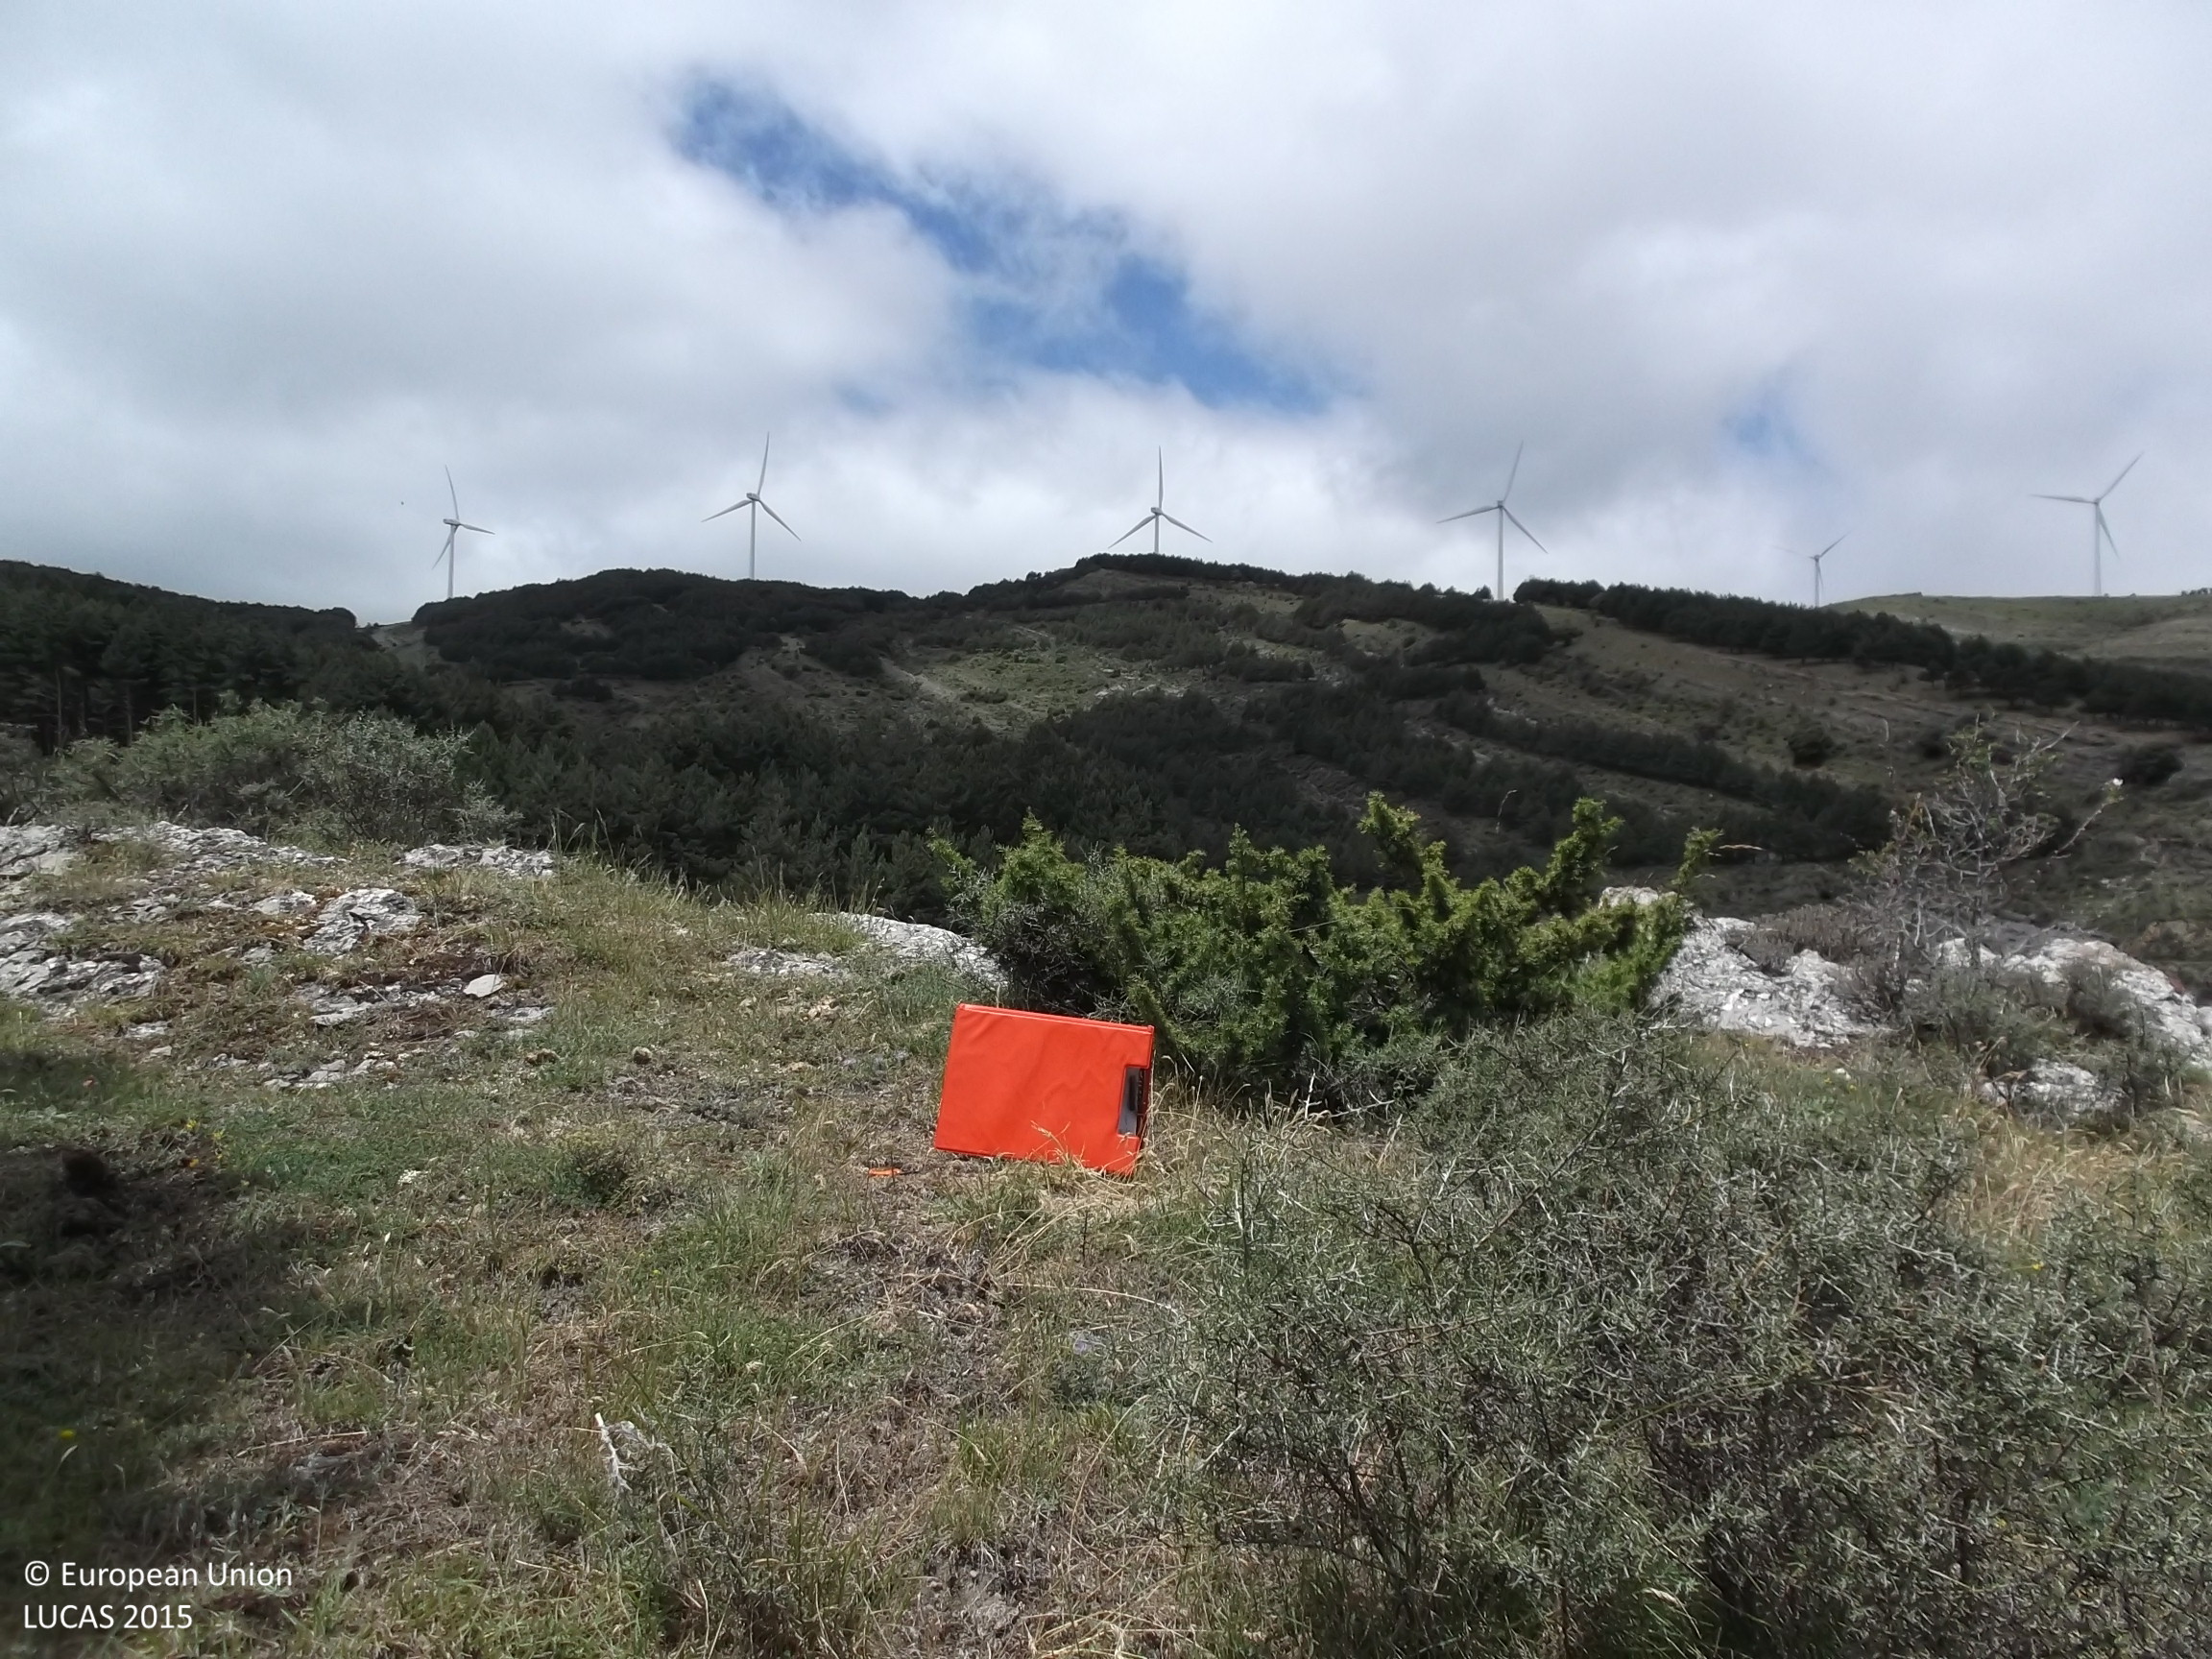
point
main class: Shrubland
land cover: Shrubland with sparse tree cover
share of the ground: 50 - 75 %
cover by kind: shrubs 50 %, herbaceous plants 30 %, unconsolidated bare surface 15 %, broadleaved forest trees 5 %
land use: Agriculture (excluding fallow land and kitchen gardens)
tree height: < 5 m
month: June
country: ES
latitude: 42.1835
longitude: -2.3789
